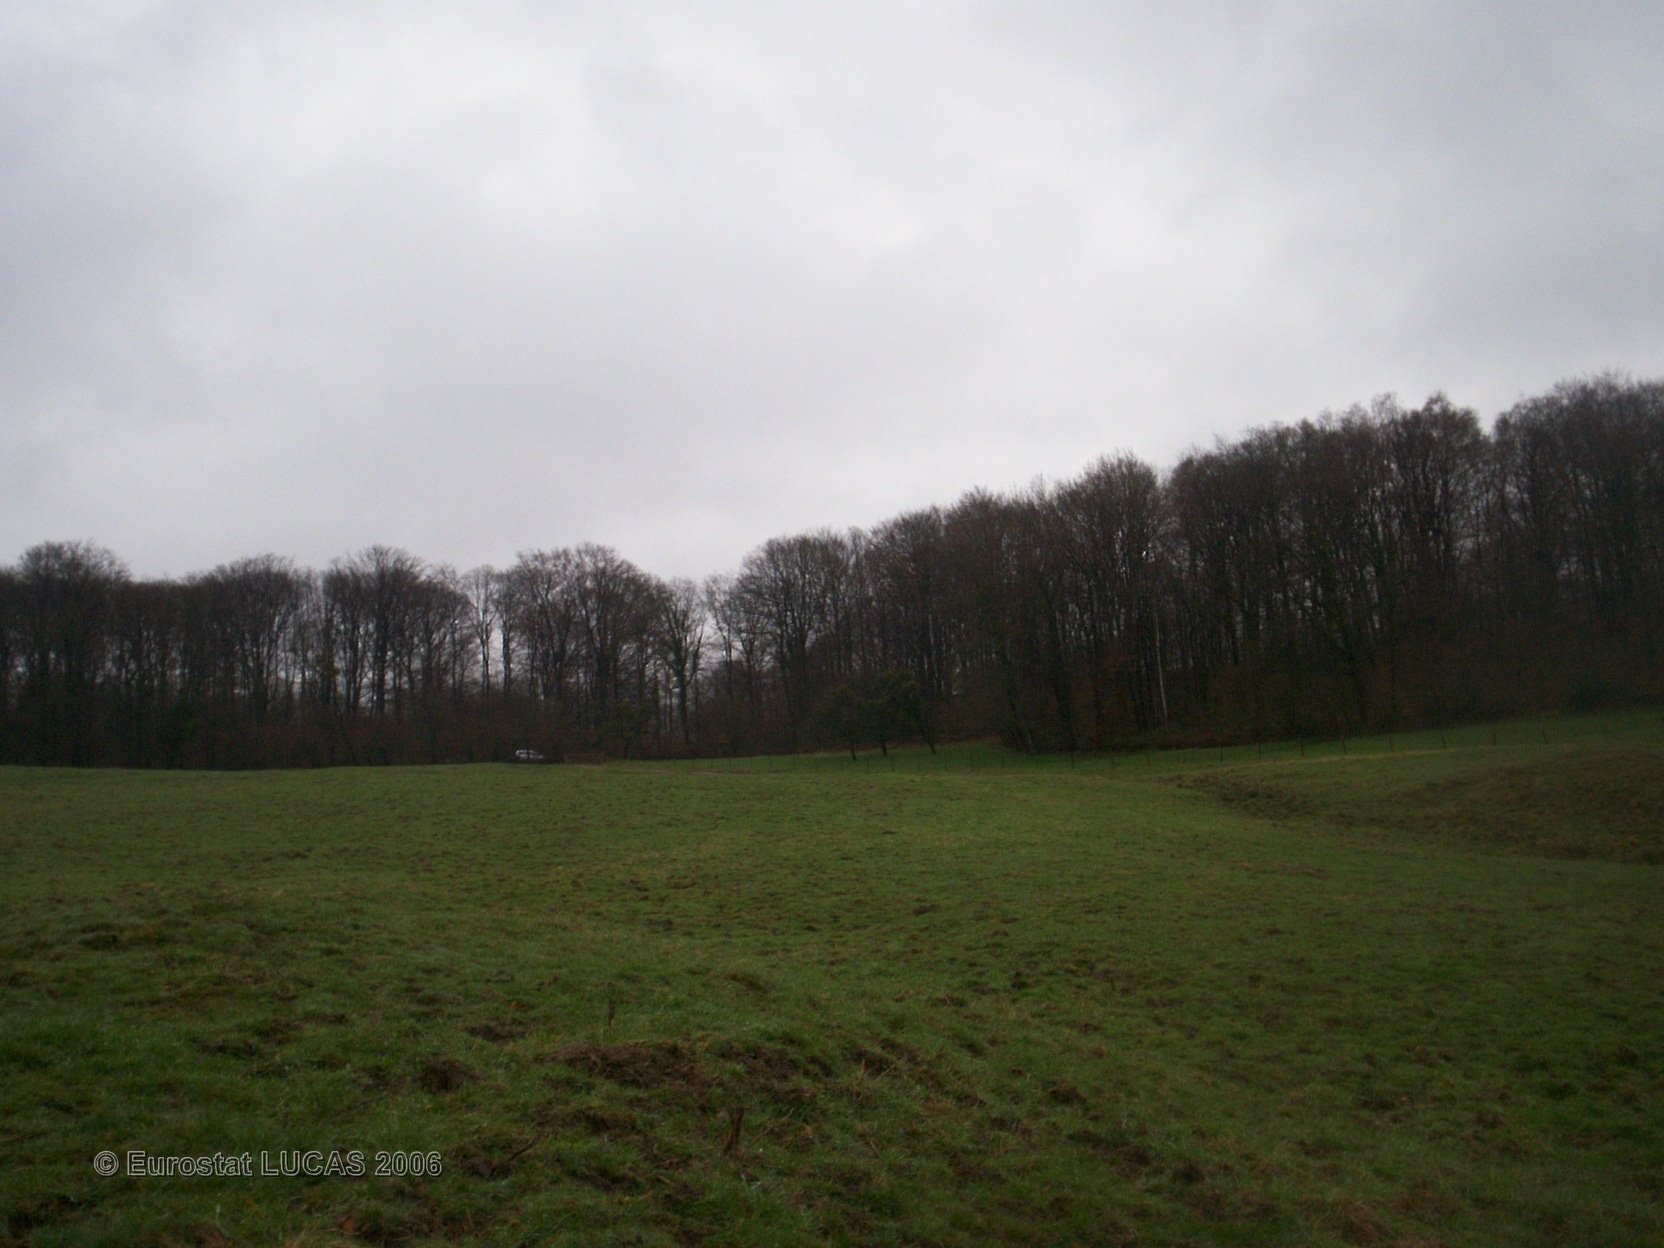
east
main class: Grassland
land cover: Grassland without tree/shrub cover
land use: Agriculture (excluding fallow land and kitchen gardens)
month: April
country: FR
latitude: 49.3204
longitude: 5.0588
